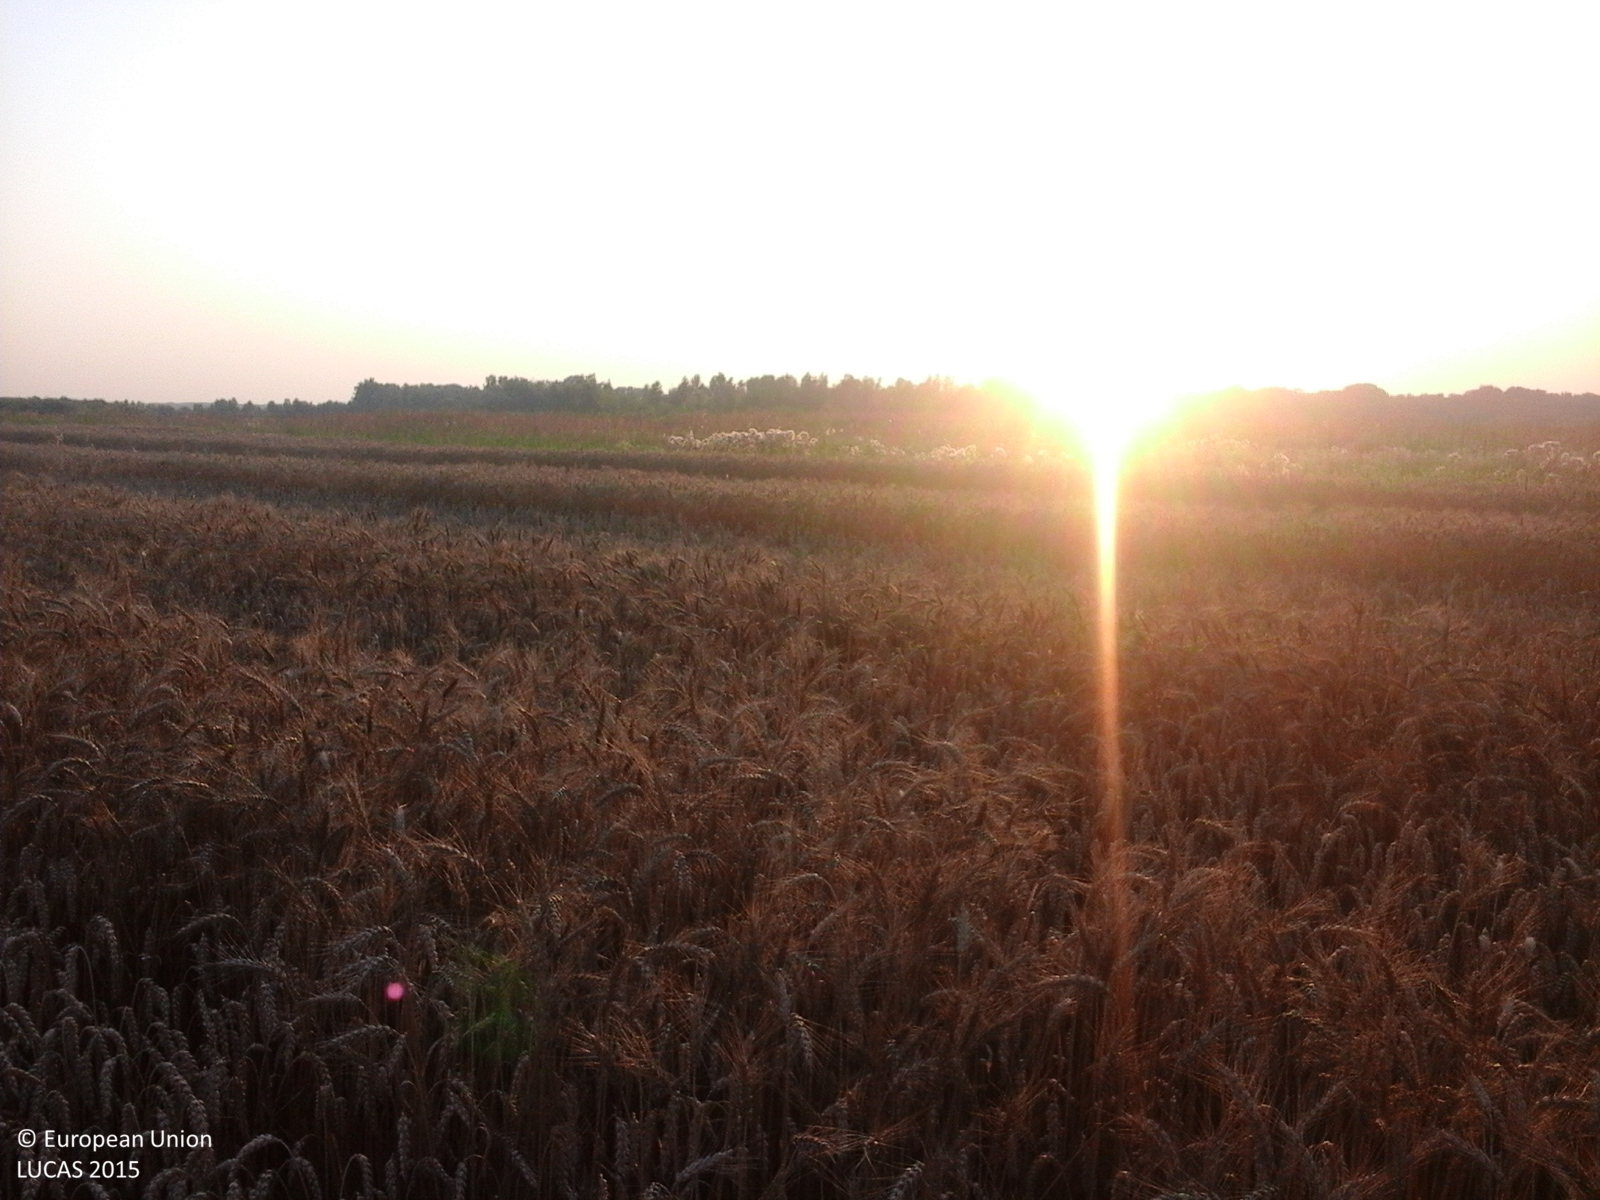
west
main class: Cropland
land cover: Common wheat
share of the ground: > 75 %
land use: Agriculture (excluding fallow land and kitchen gardens)
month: July
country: RO
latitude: 44.5647
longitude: 25.5424
